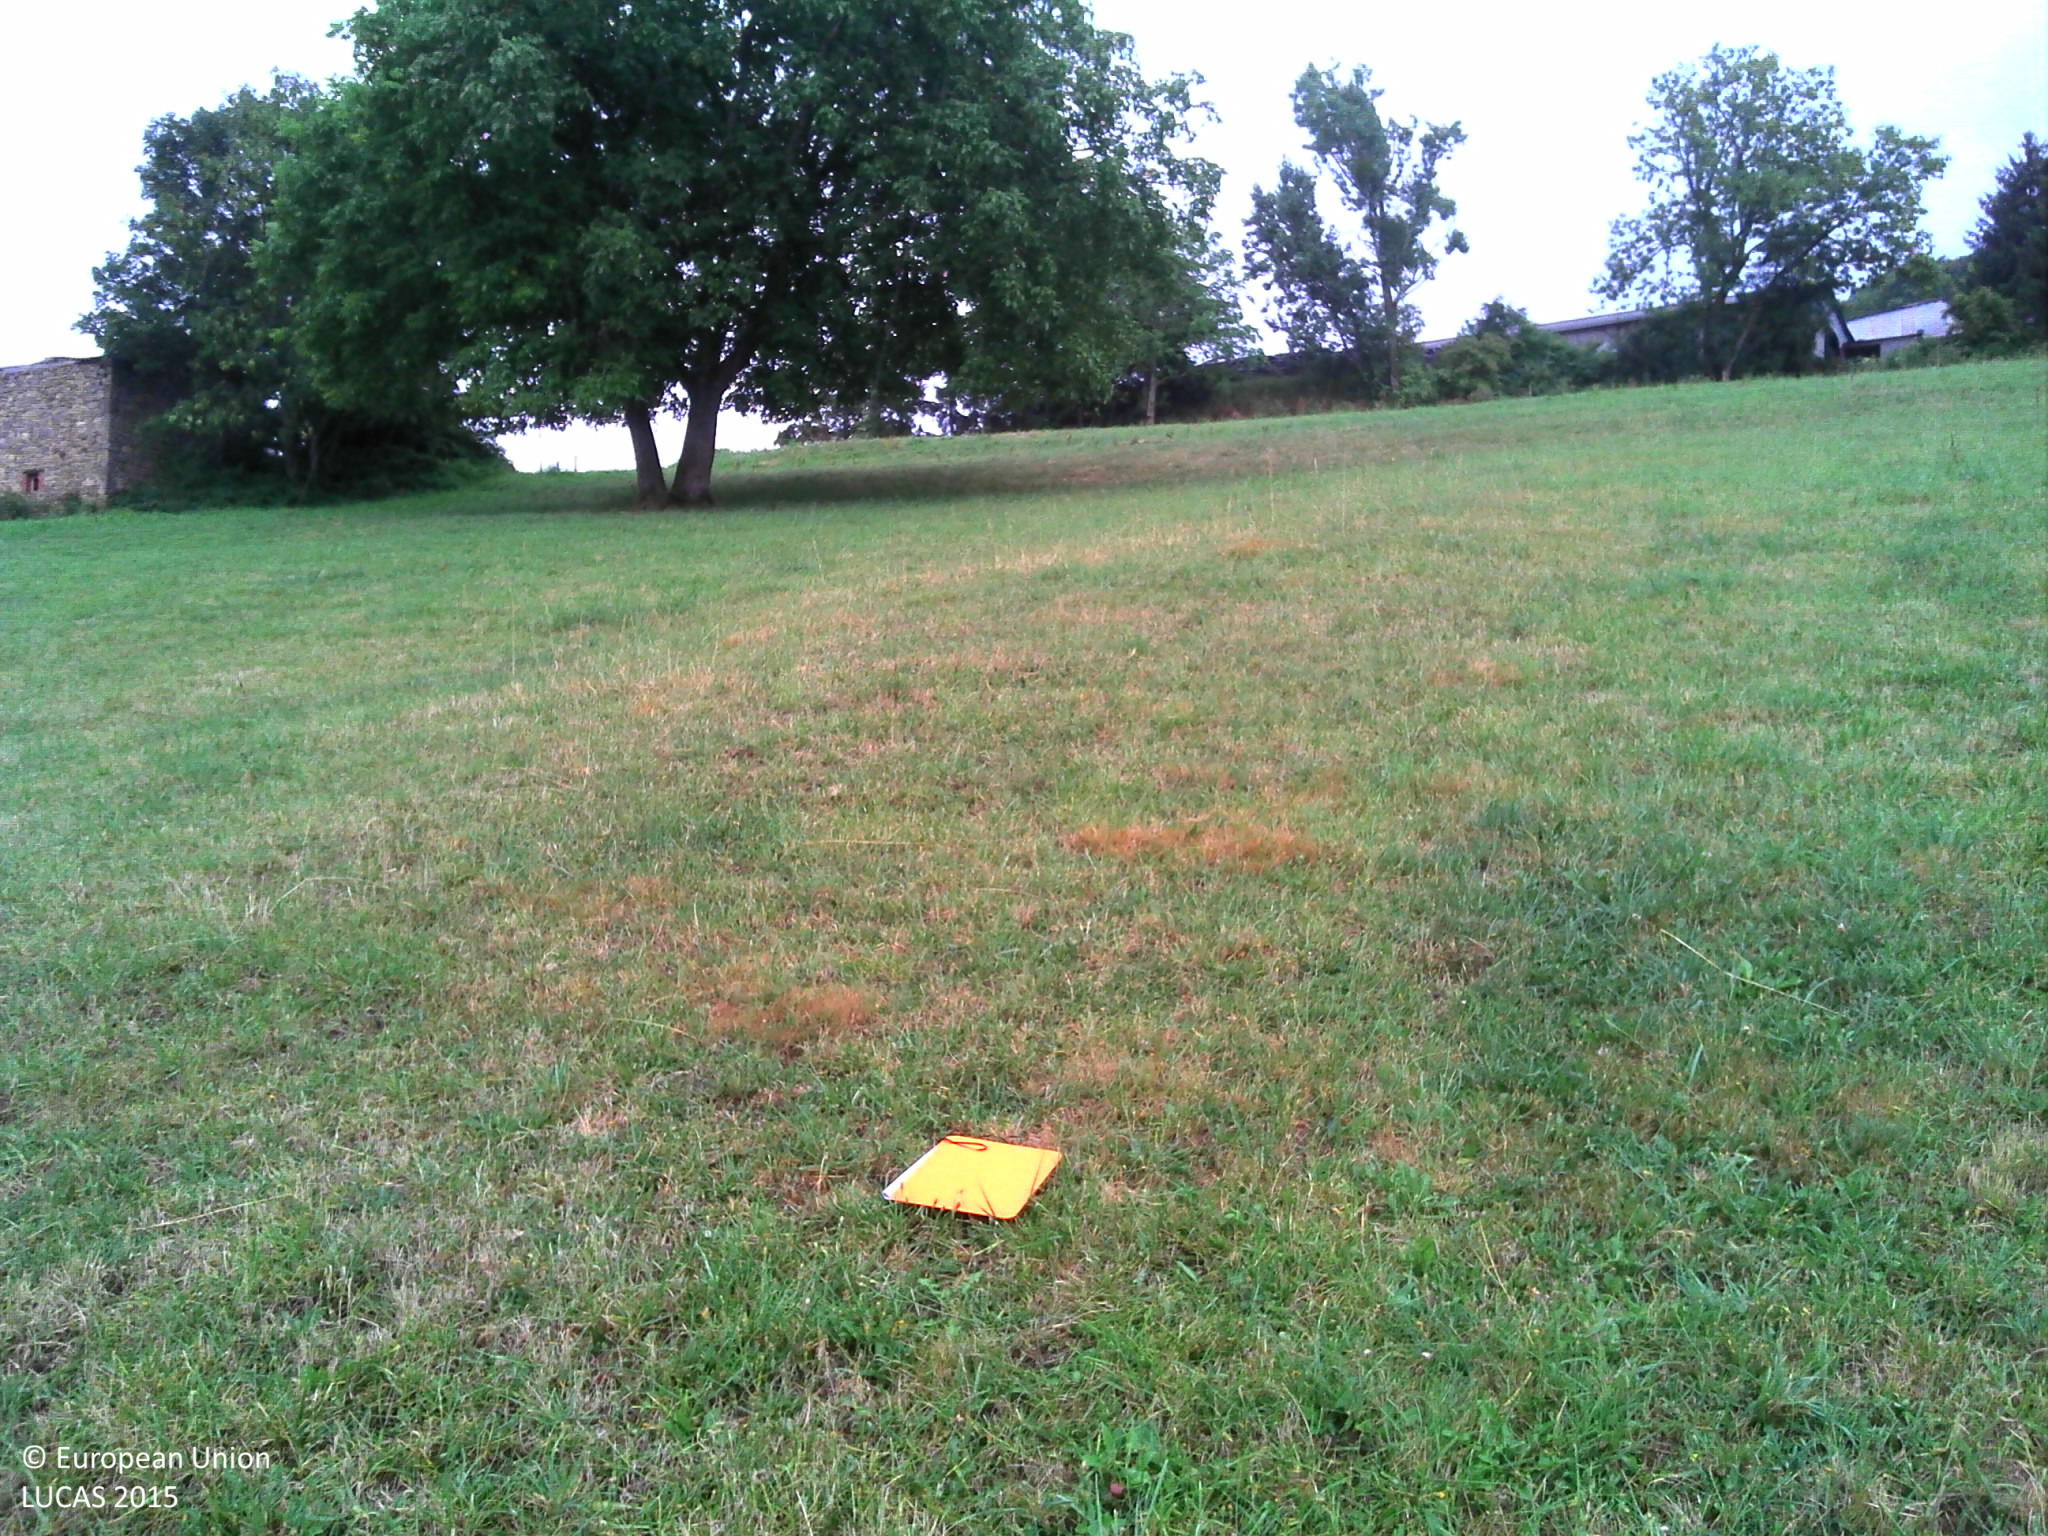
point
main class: Grassland
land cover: Grassland without tree/shrub cover
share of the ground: > 75 %
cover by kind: herbaceous plants 100 %
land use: Agriculture (excluding fallow land and kitchen gardens)
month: August
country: FR
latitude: 45.2713
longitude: 4.5108
